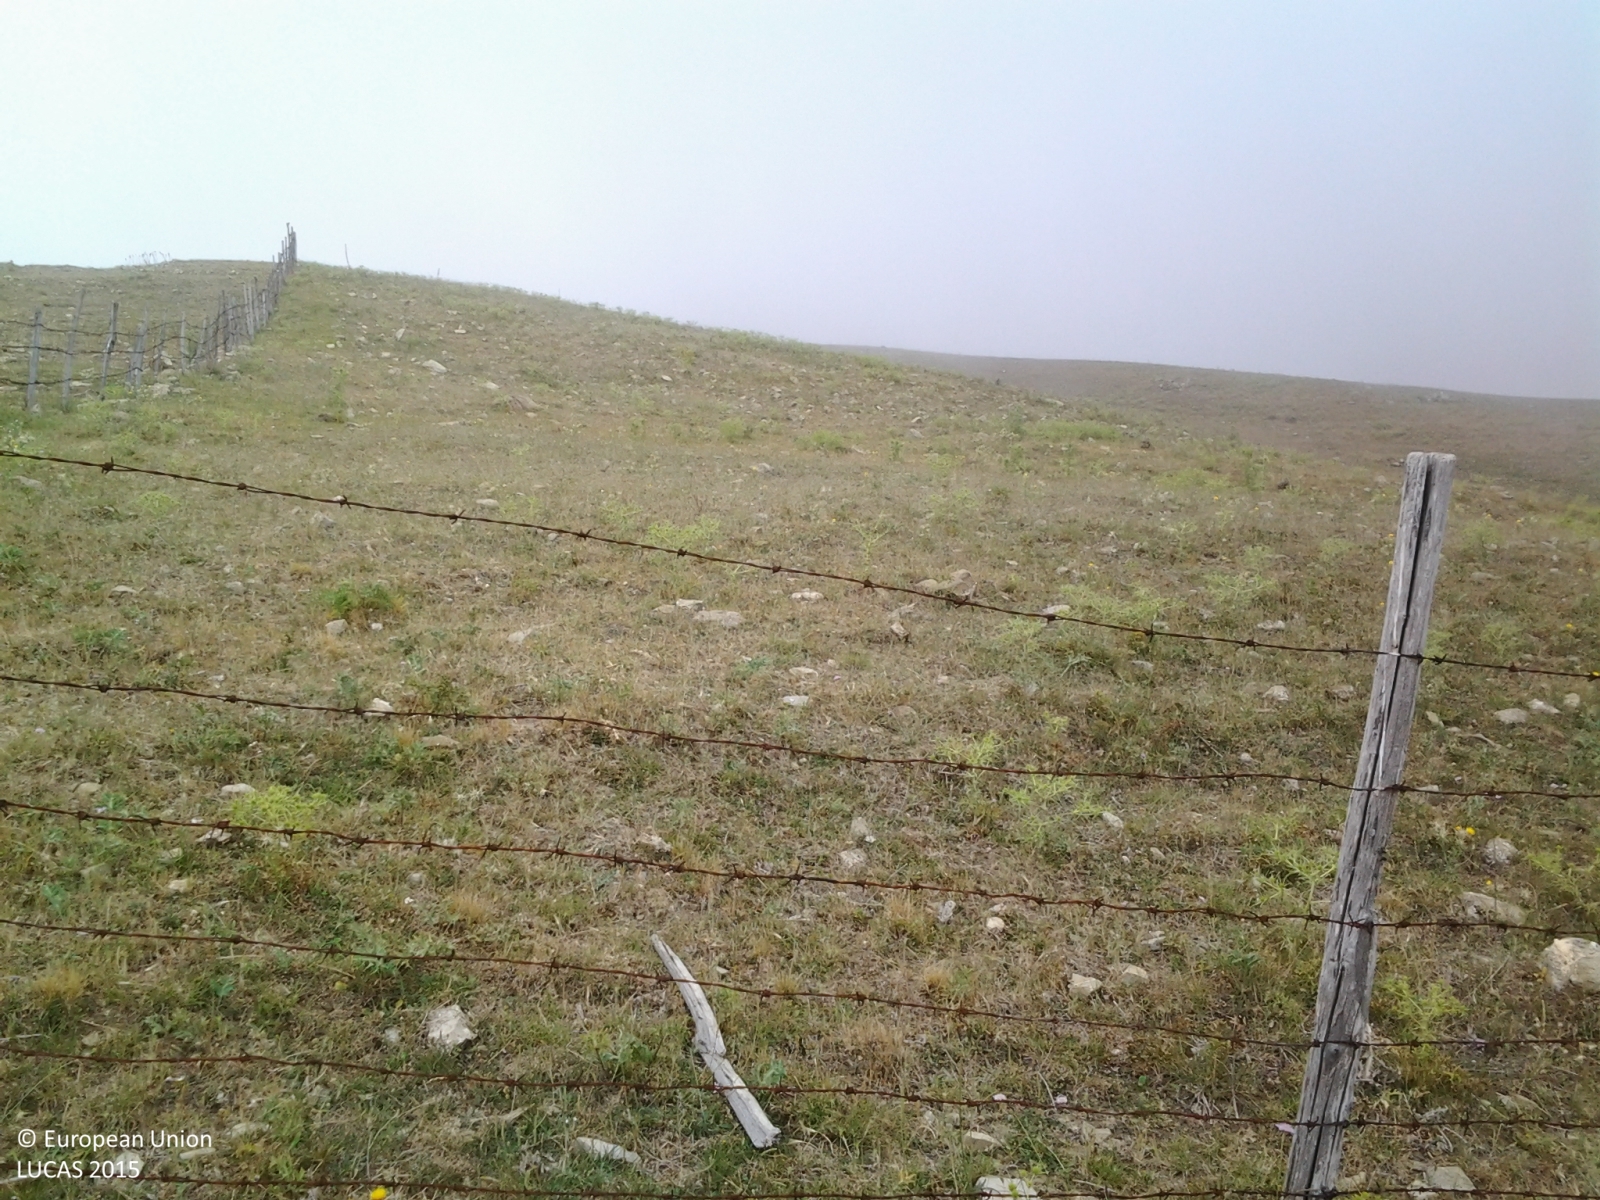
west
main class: Grassland
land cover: Spontaneously vegetated surfaces
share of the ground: > 75 %
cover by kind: herbaceous plants 90 %, shrubs 5 %, unconsolidated bare surface 5 %
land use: Agriculture (excluding fallow land and kitchen gardens)
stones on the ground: > 50 %
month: July
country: IT
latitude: 37.9691
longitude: 14.8507
